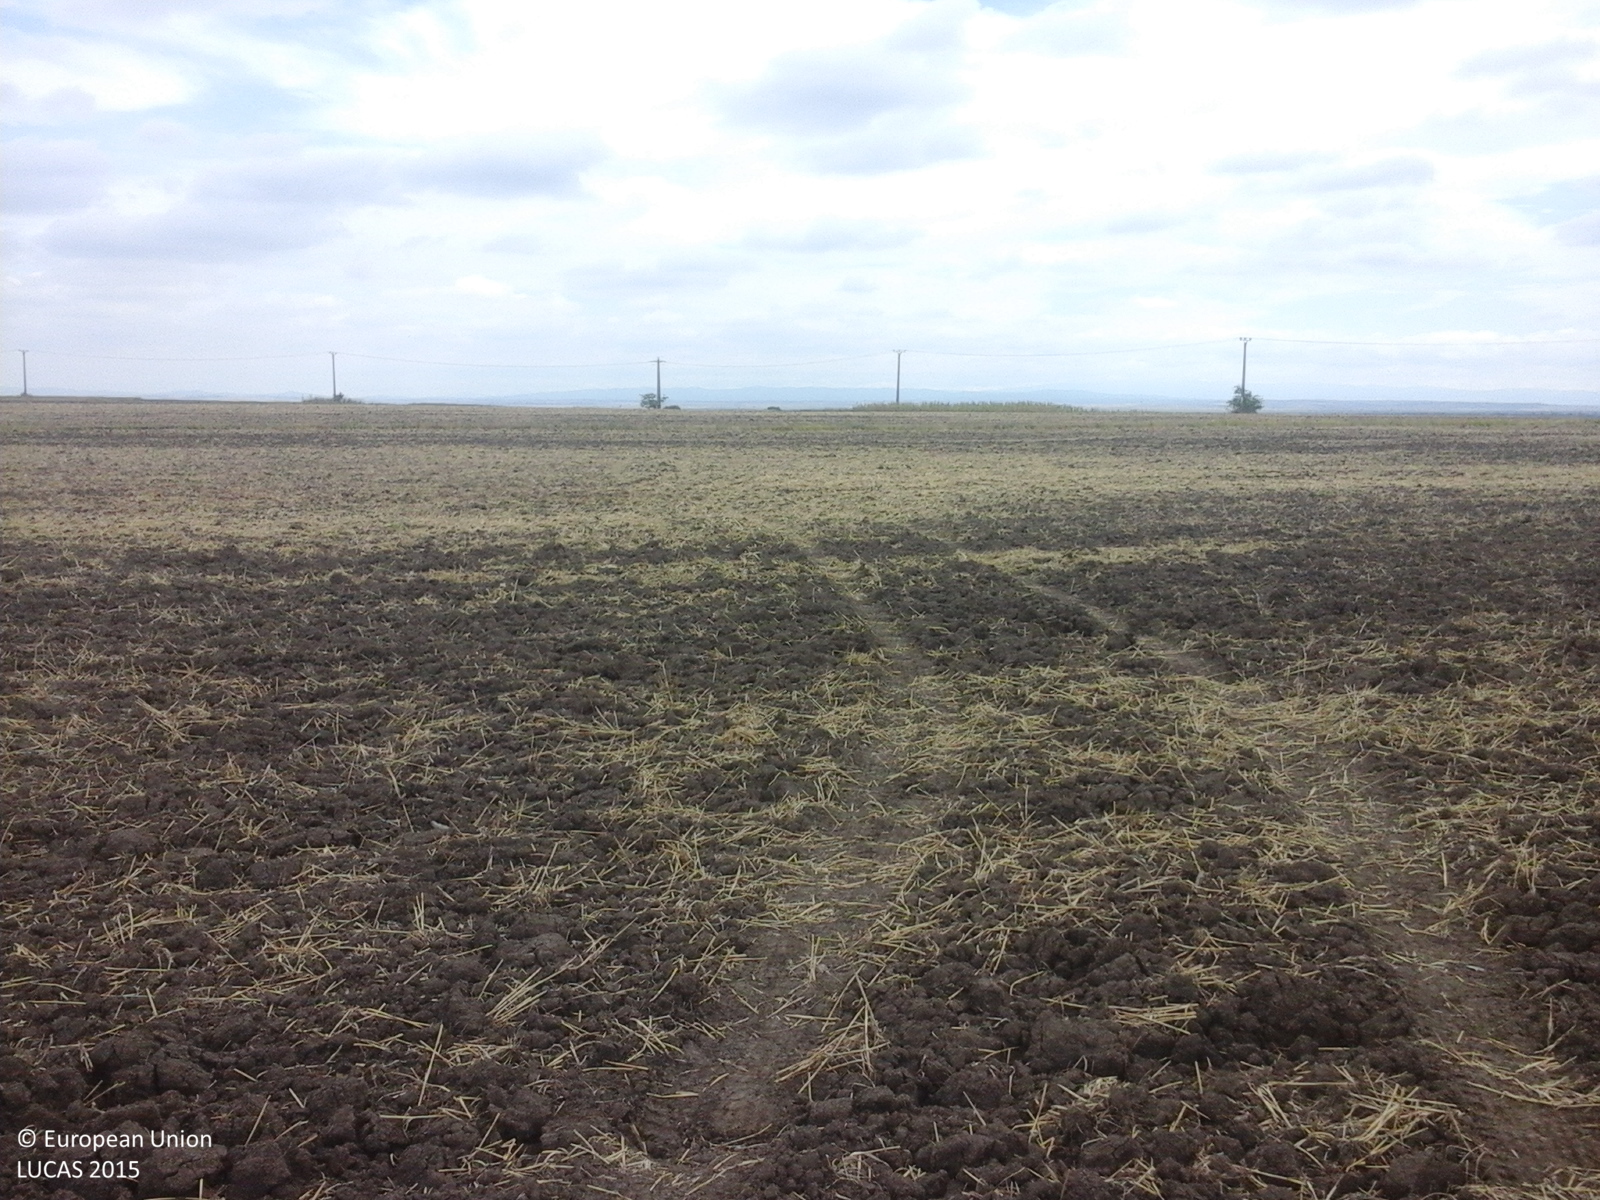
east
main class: Cropland
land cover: Common wheat
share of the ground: < 10 %
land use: Agriculture (excluding fallow land and kitchen gardens)
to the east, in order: Common wheat; Tracks
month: August
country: RO
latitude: 45.2970
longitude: 21.2885
